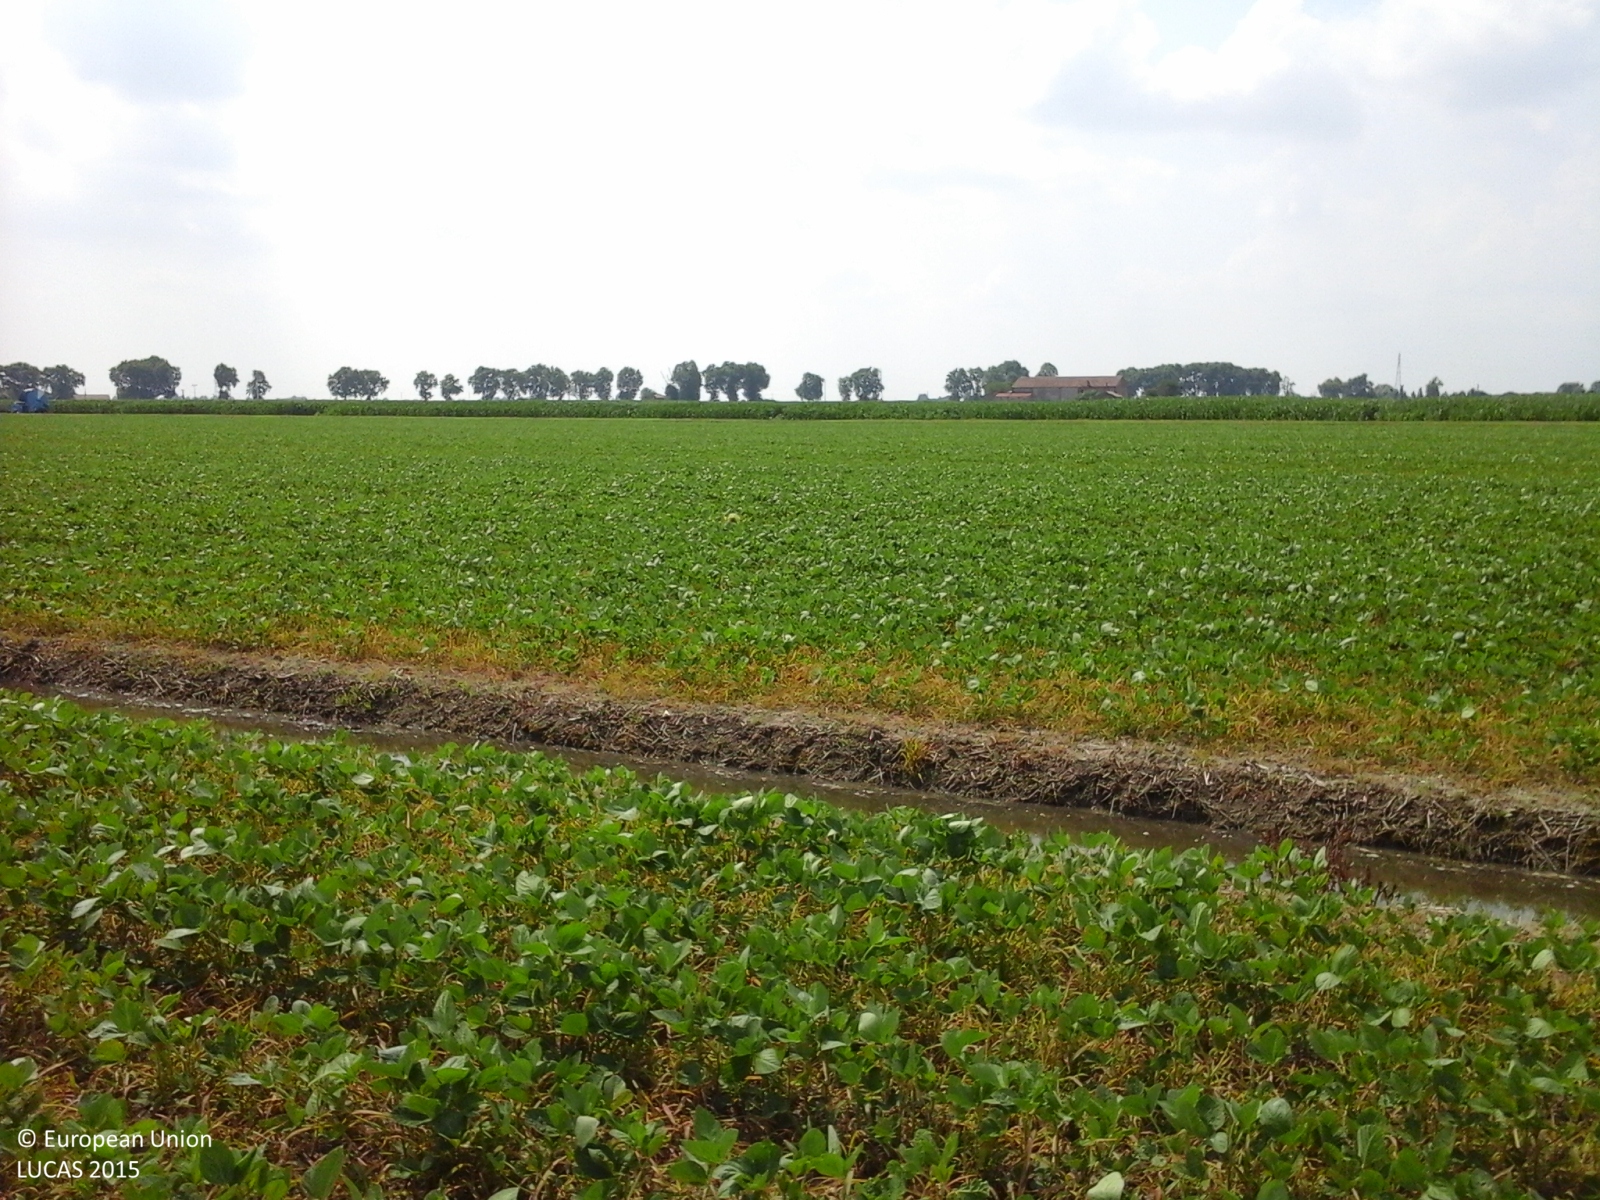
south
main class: Cropland
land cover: Soya
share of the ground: 50 - 75 %
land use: Agriculture (excluding fallow land and kitchen gardens)
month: June
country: IT
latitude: 44.8381
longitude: 11.9065
